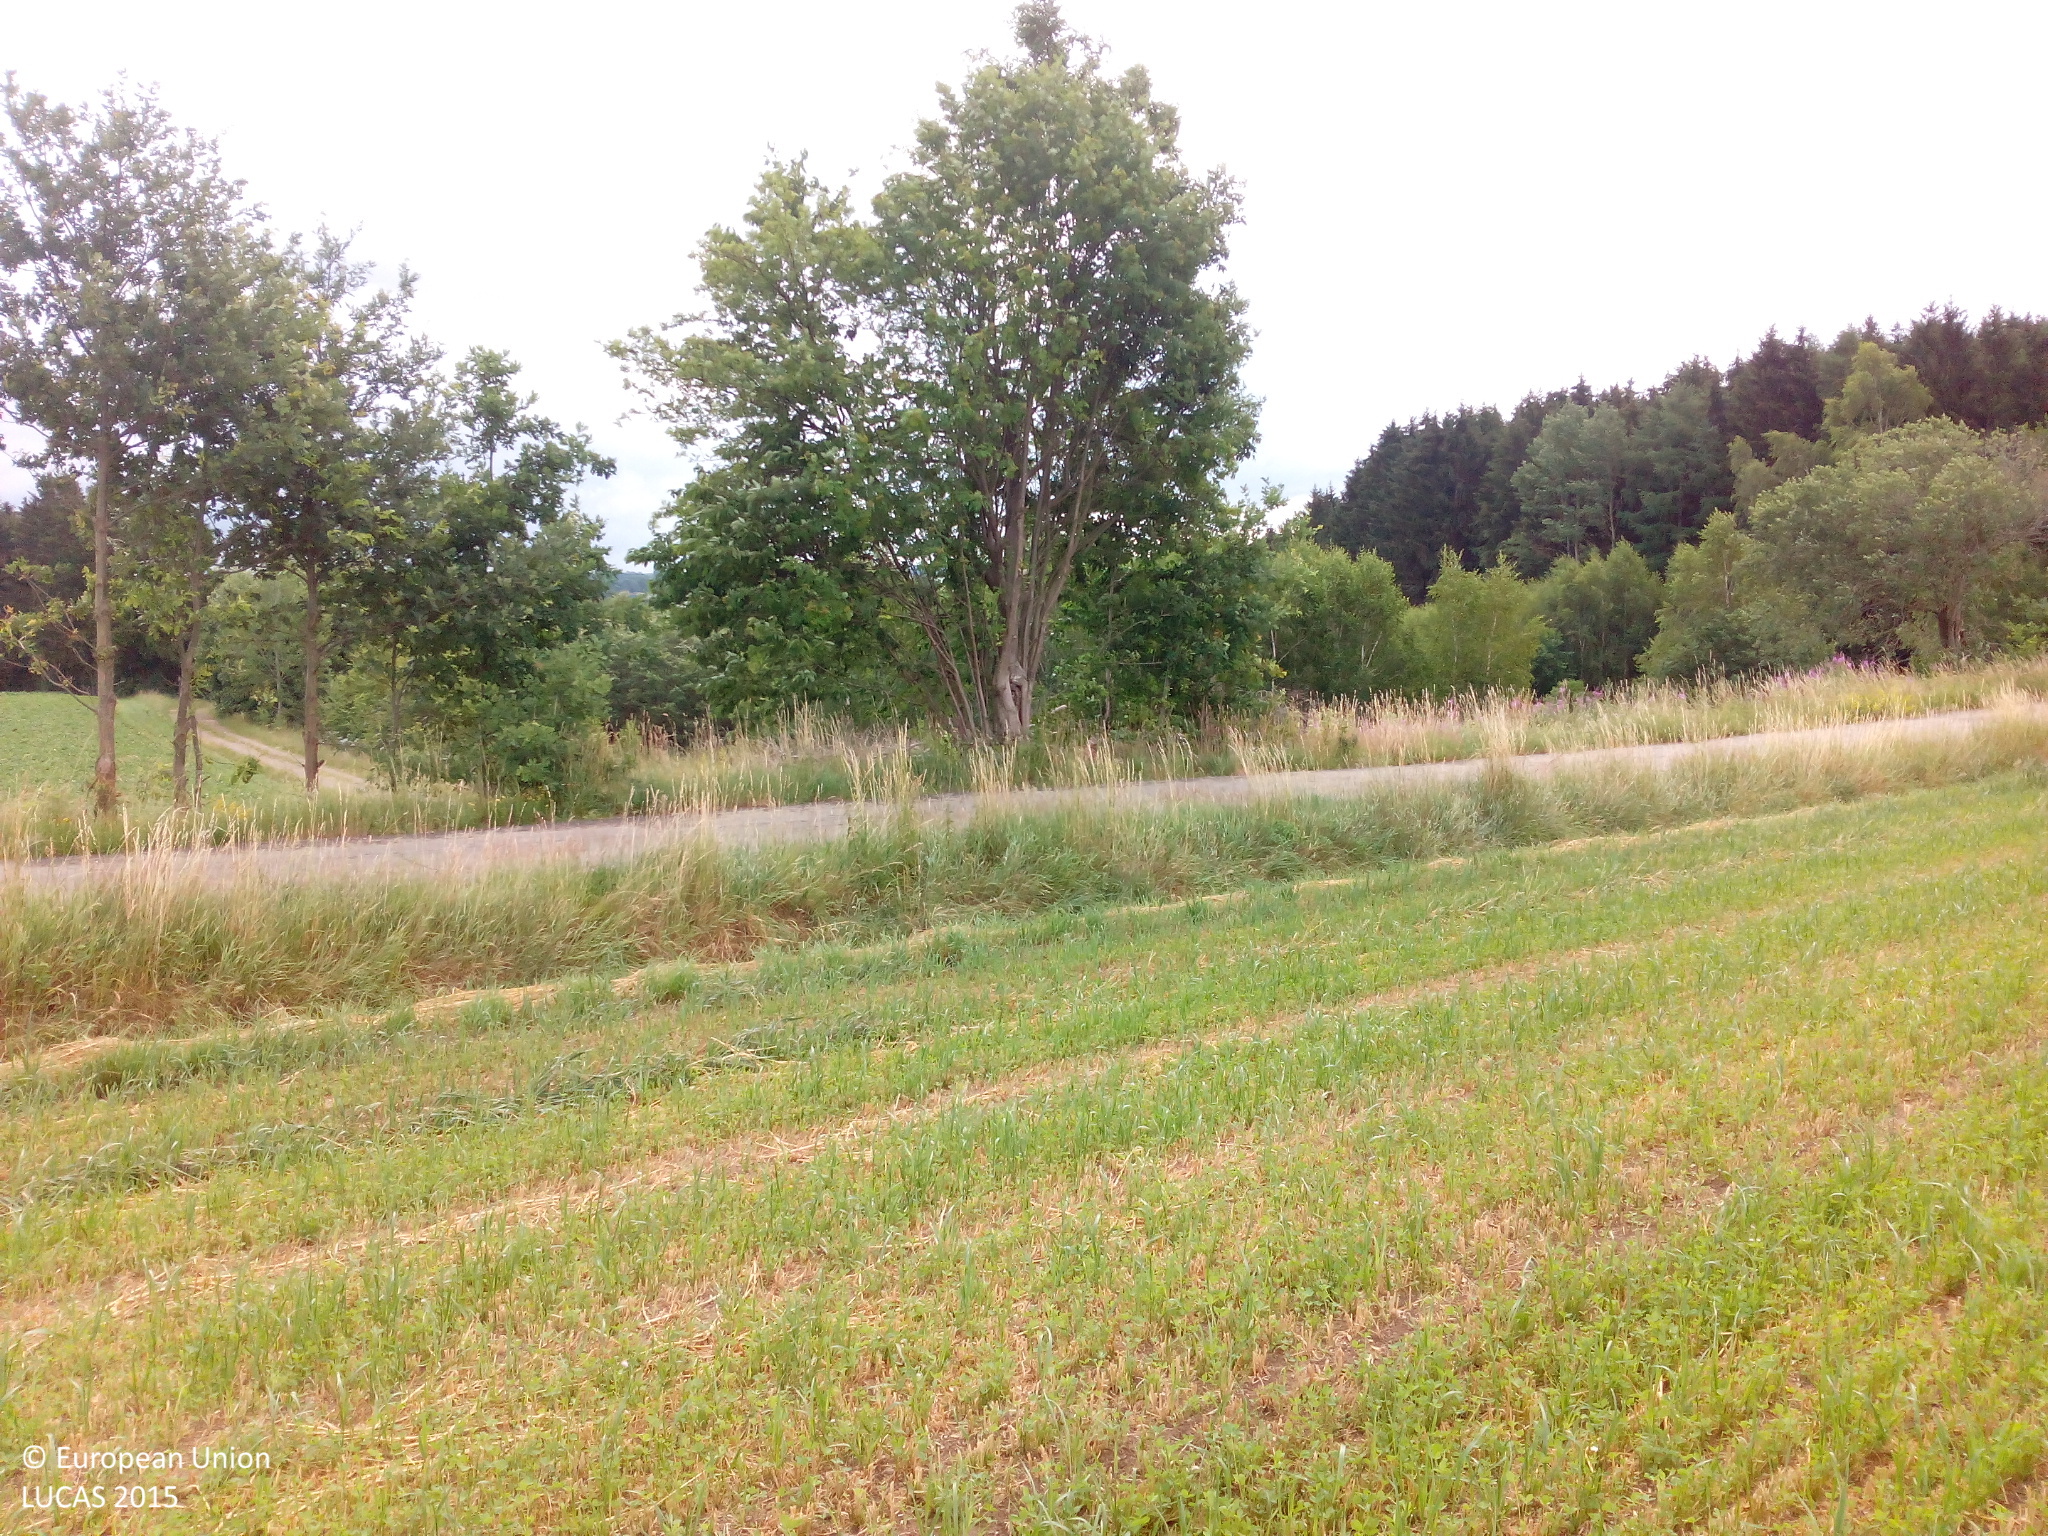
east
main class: Cropland
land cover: Temporary grasslands
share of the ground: 50 - 75 %
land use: Agriculture (excluding fallow land and kitchen gardens)
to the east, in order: Temporary grasslands; Ditches and canals; Grass margins; Paved roads, cycling and walking lanes; Abandoned hedges; Grass margins; Other bare soil; Broadleaved woodland; Spruce dominated mixed woodland; Spruce dominated coniferous woodland; Spontaneously vegetated surfaces; Tracks; Spontaneously vegetated surfaces; Spruce dominated coniferous woodland; Shrubland without tree cover
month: July
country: DE
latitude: 49.5834
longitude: 12.3924
